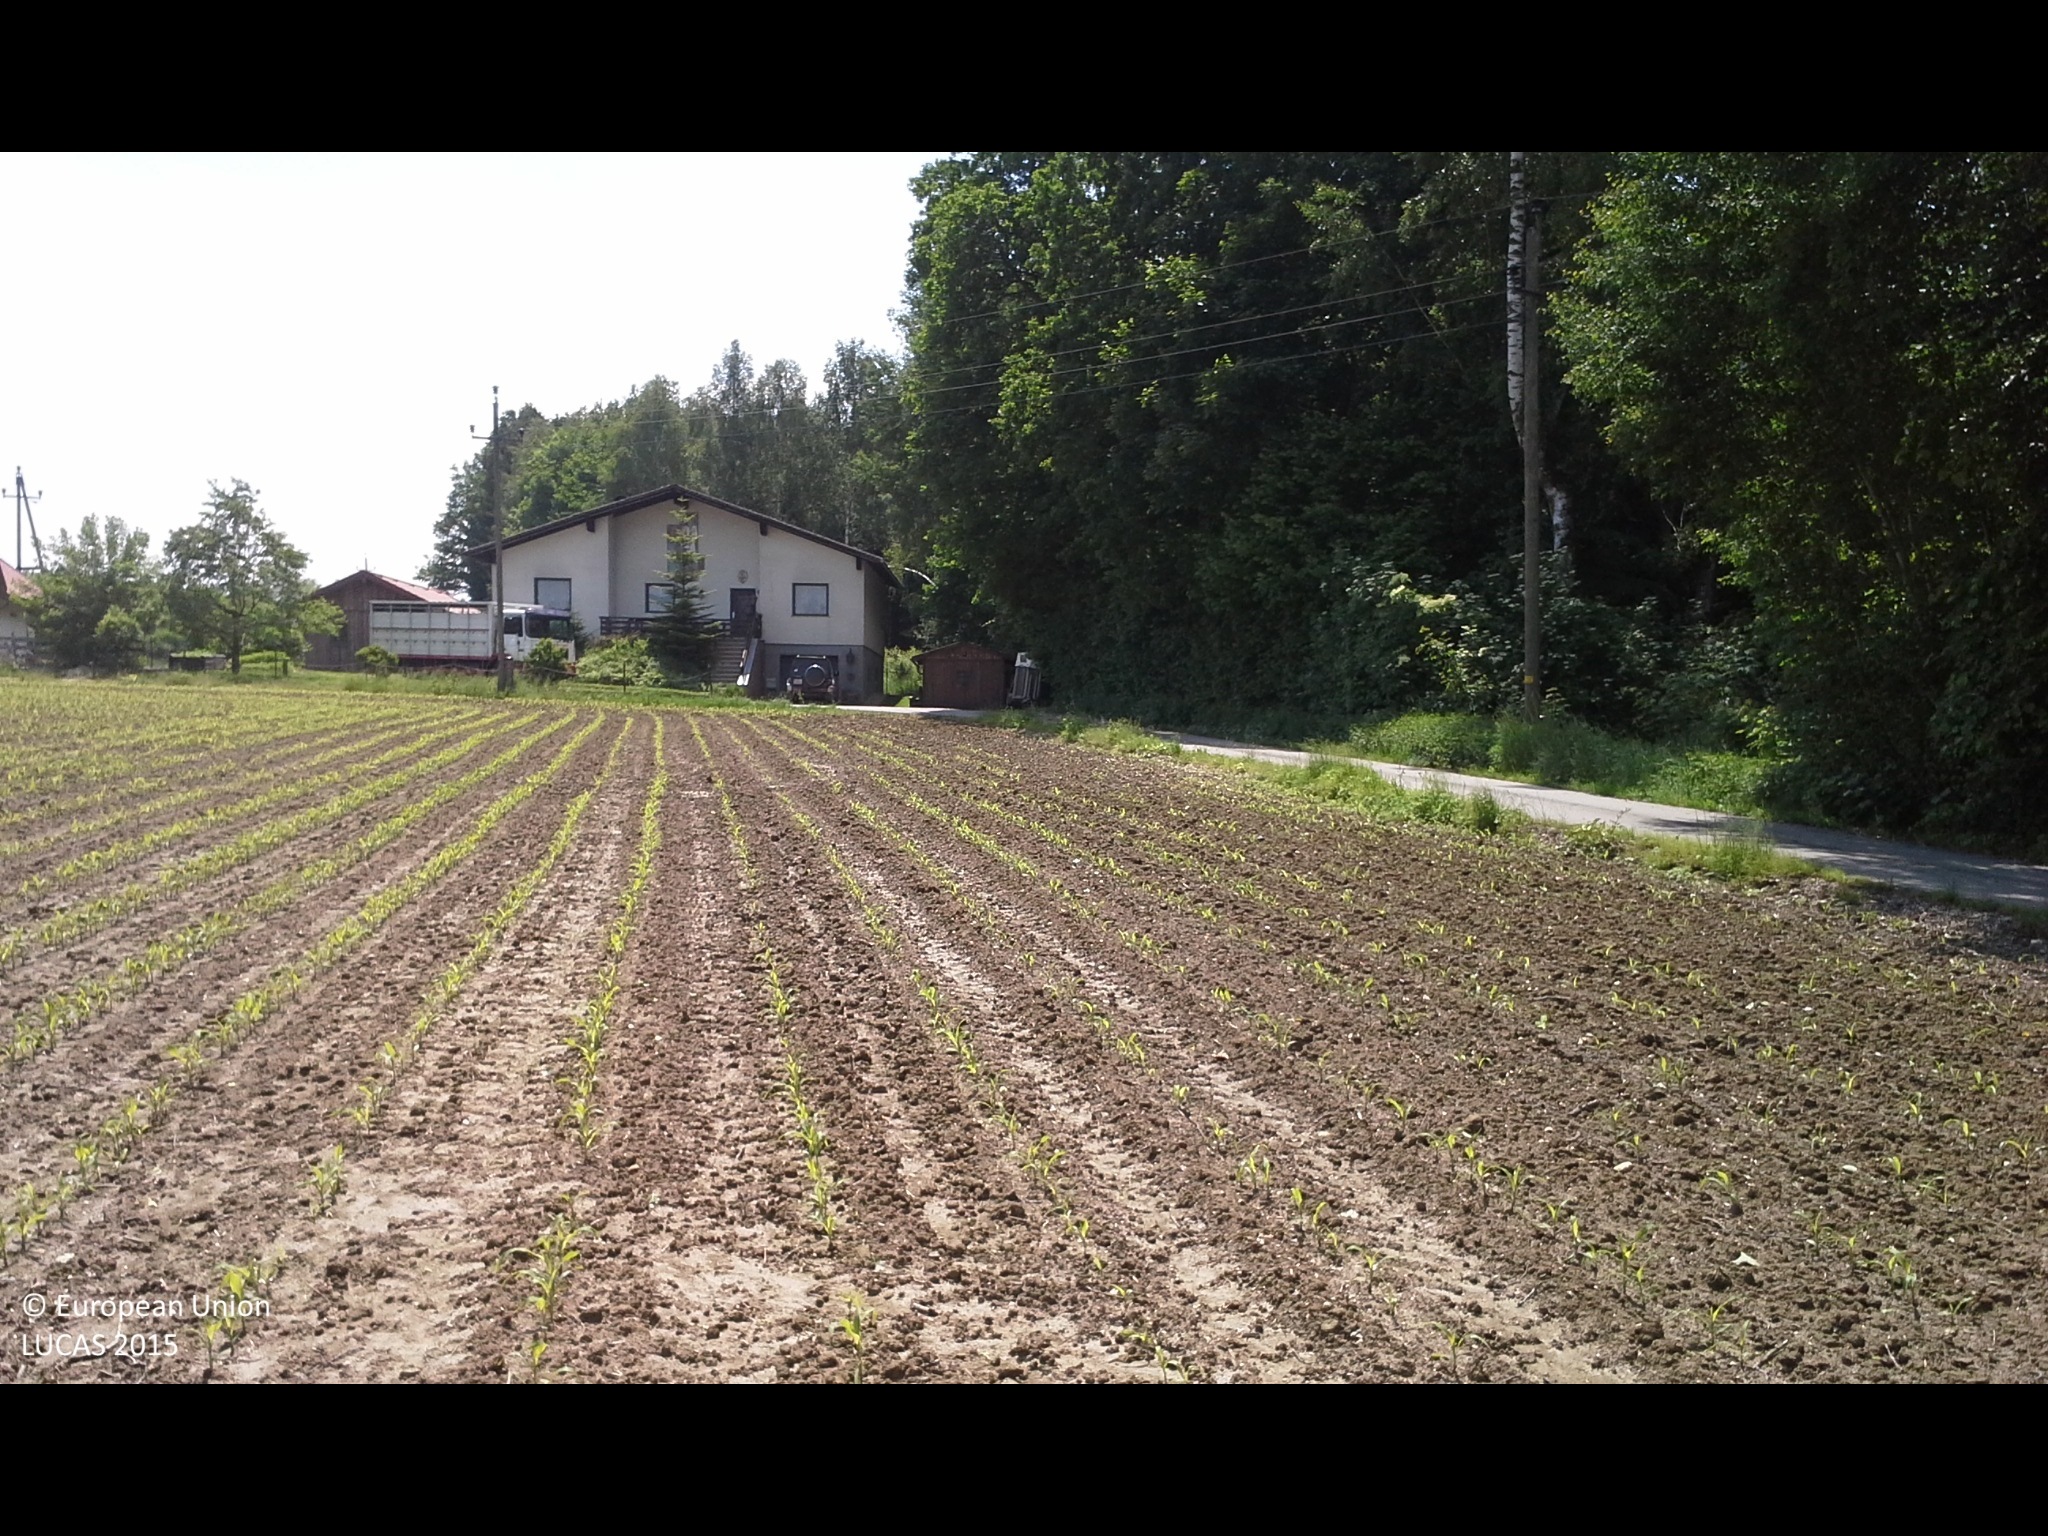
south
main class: Cropland
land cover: Maize
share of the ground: 10 - 25 %
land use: Agriculture (excluding fallow land and kitchen gardens)
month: May
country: AT
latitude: 47.9986
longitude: 14.2213
